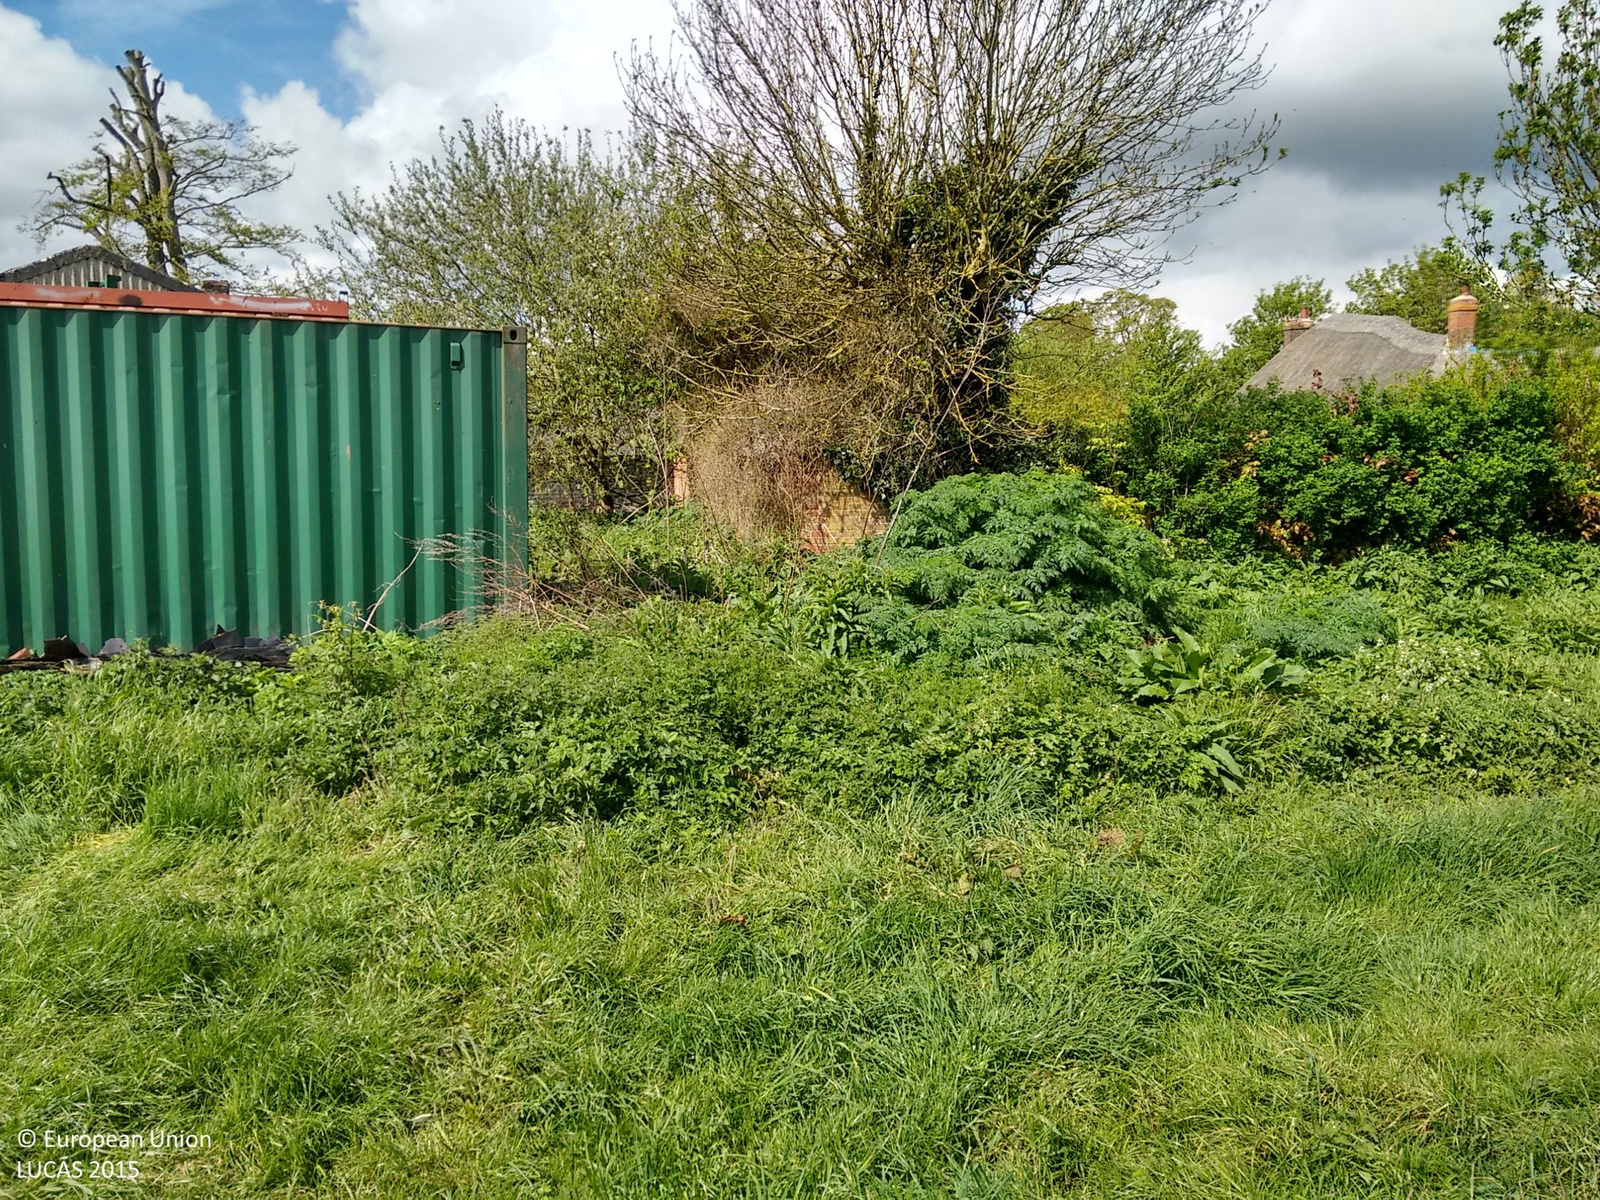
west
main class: Cropland
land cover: Common wheat
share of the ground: > 75 %
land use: Agriculture (excluding fallow land and kitchen gardens)
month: May
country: GB
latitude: 51.2534
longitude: -1.4993
